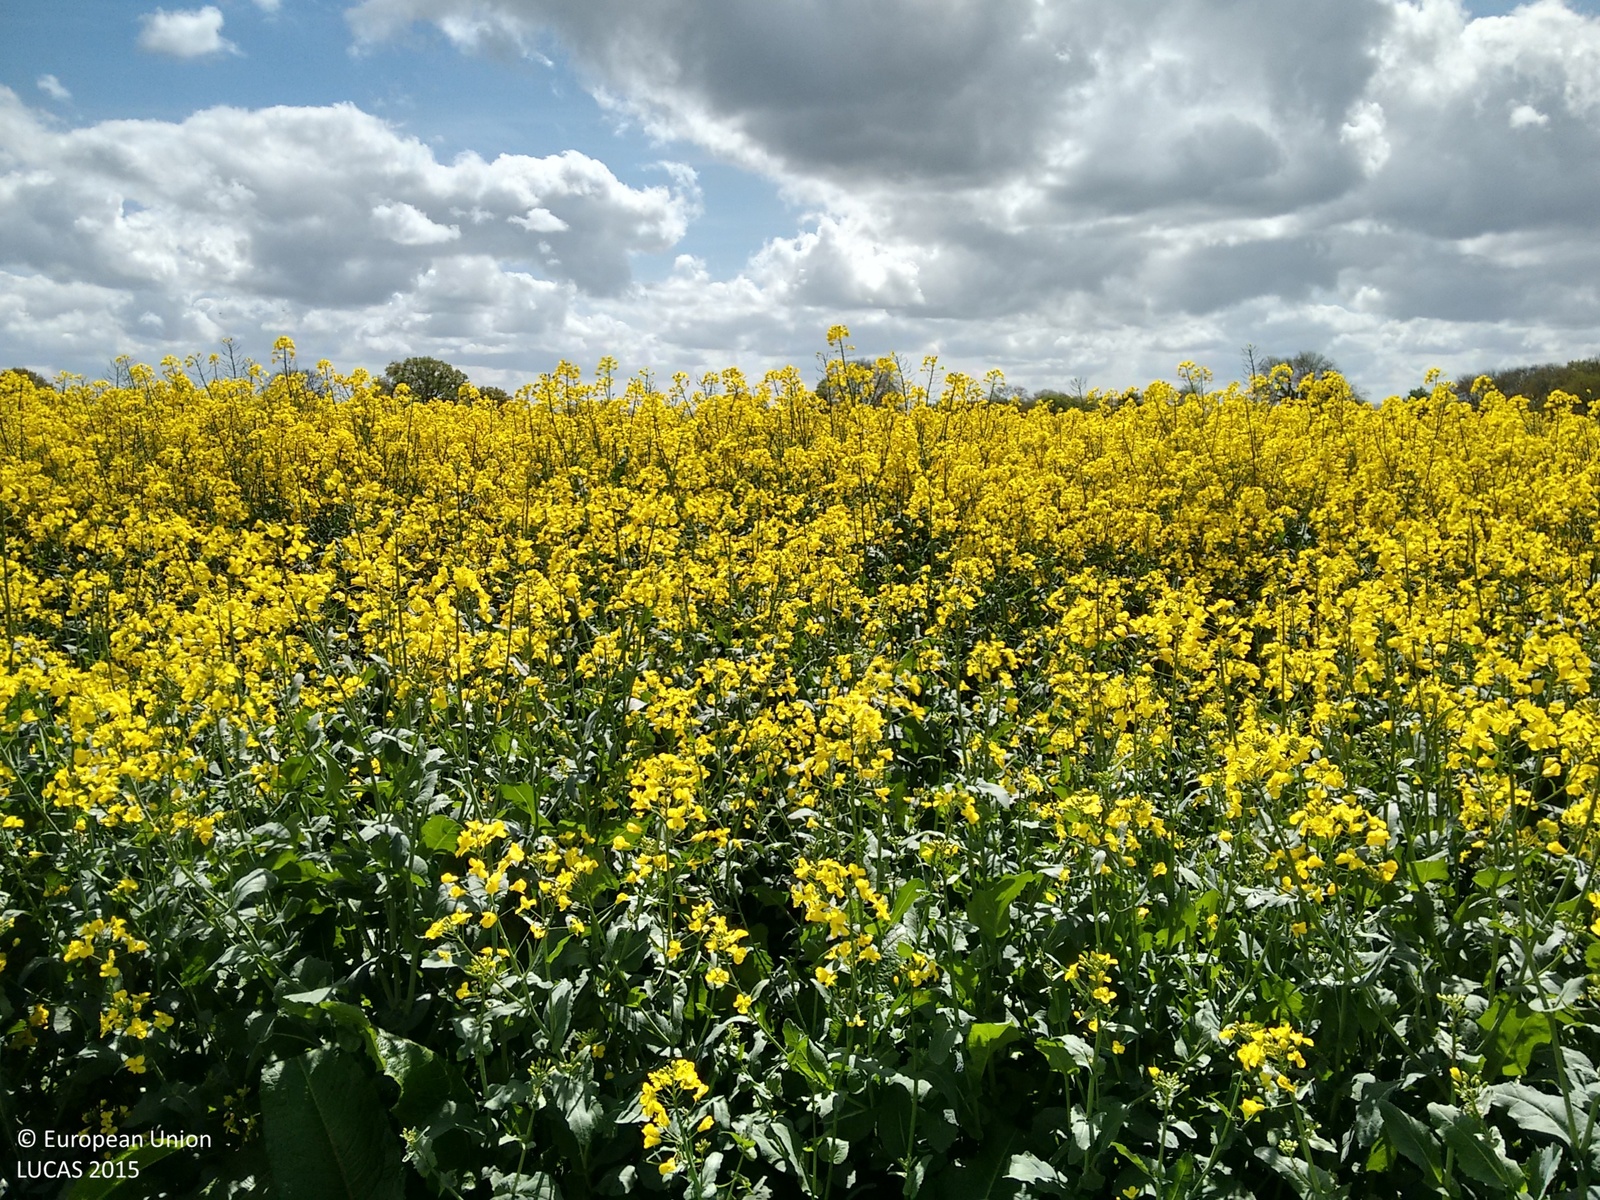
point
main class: Cropland
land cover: Rape and turnip rape
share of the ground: > 75 %
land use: Agriculture (excluding fallow land and kitchen gardens)
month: May
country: GB
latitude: 51.2683
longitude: -1.5321
